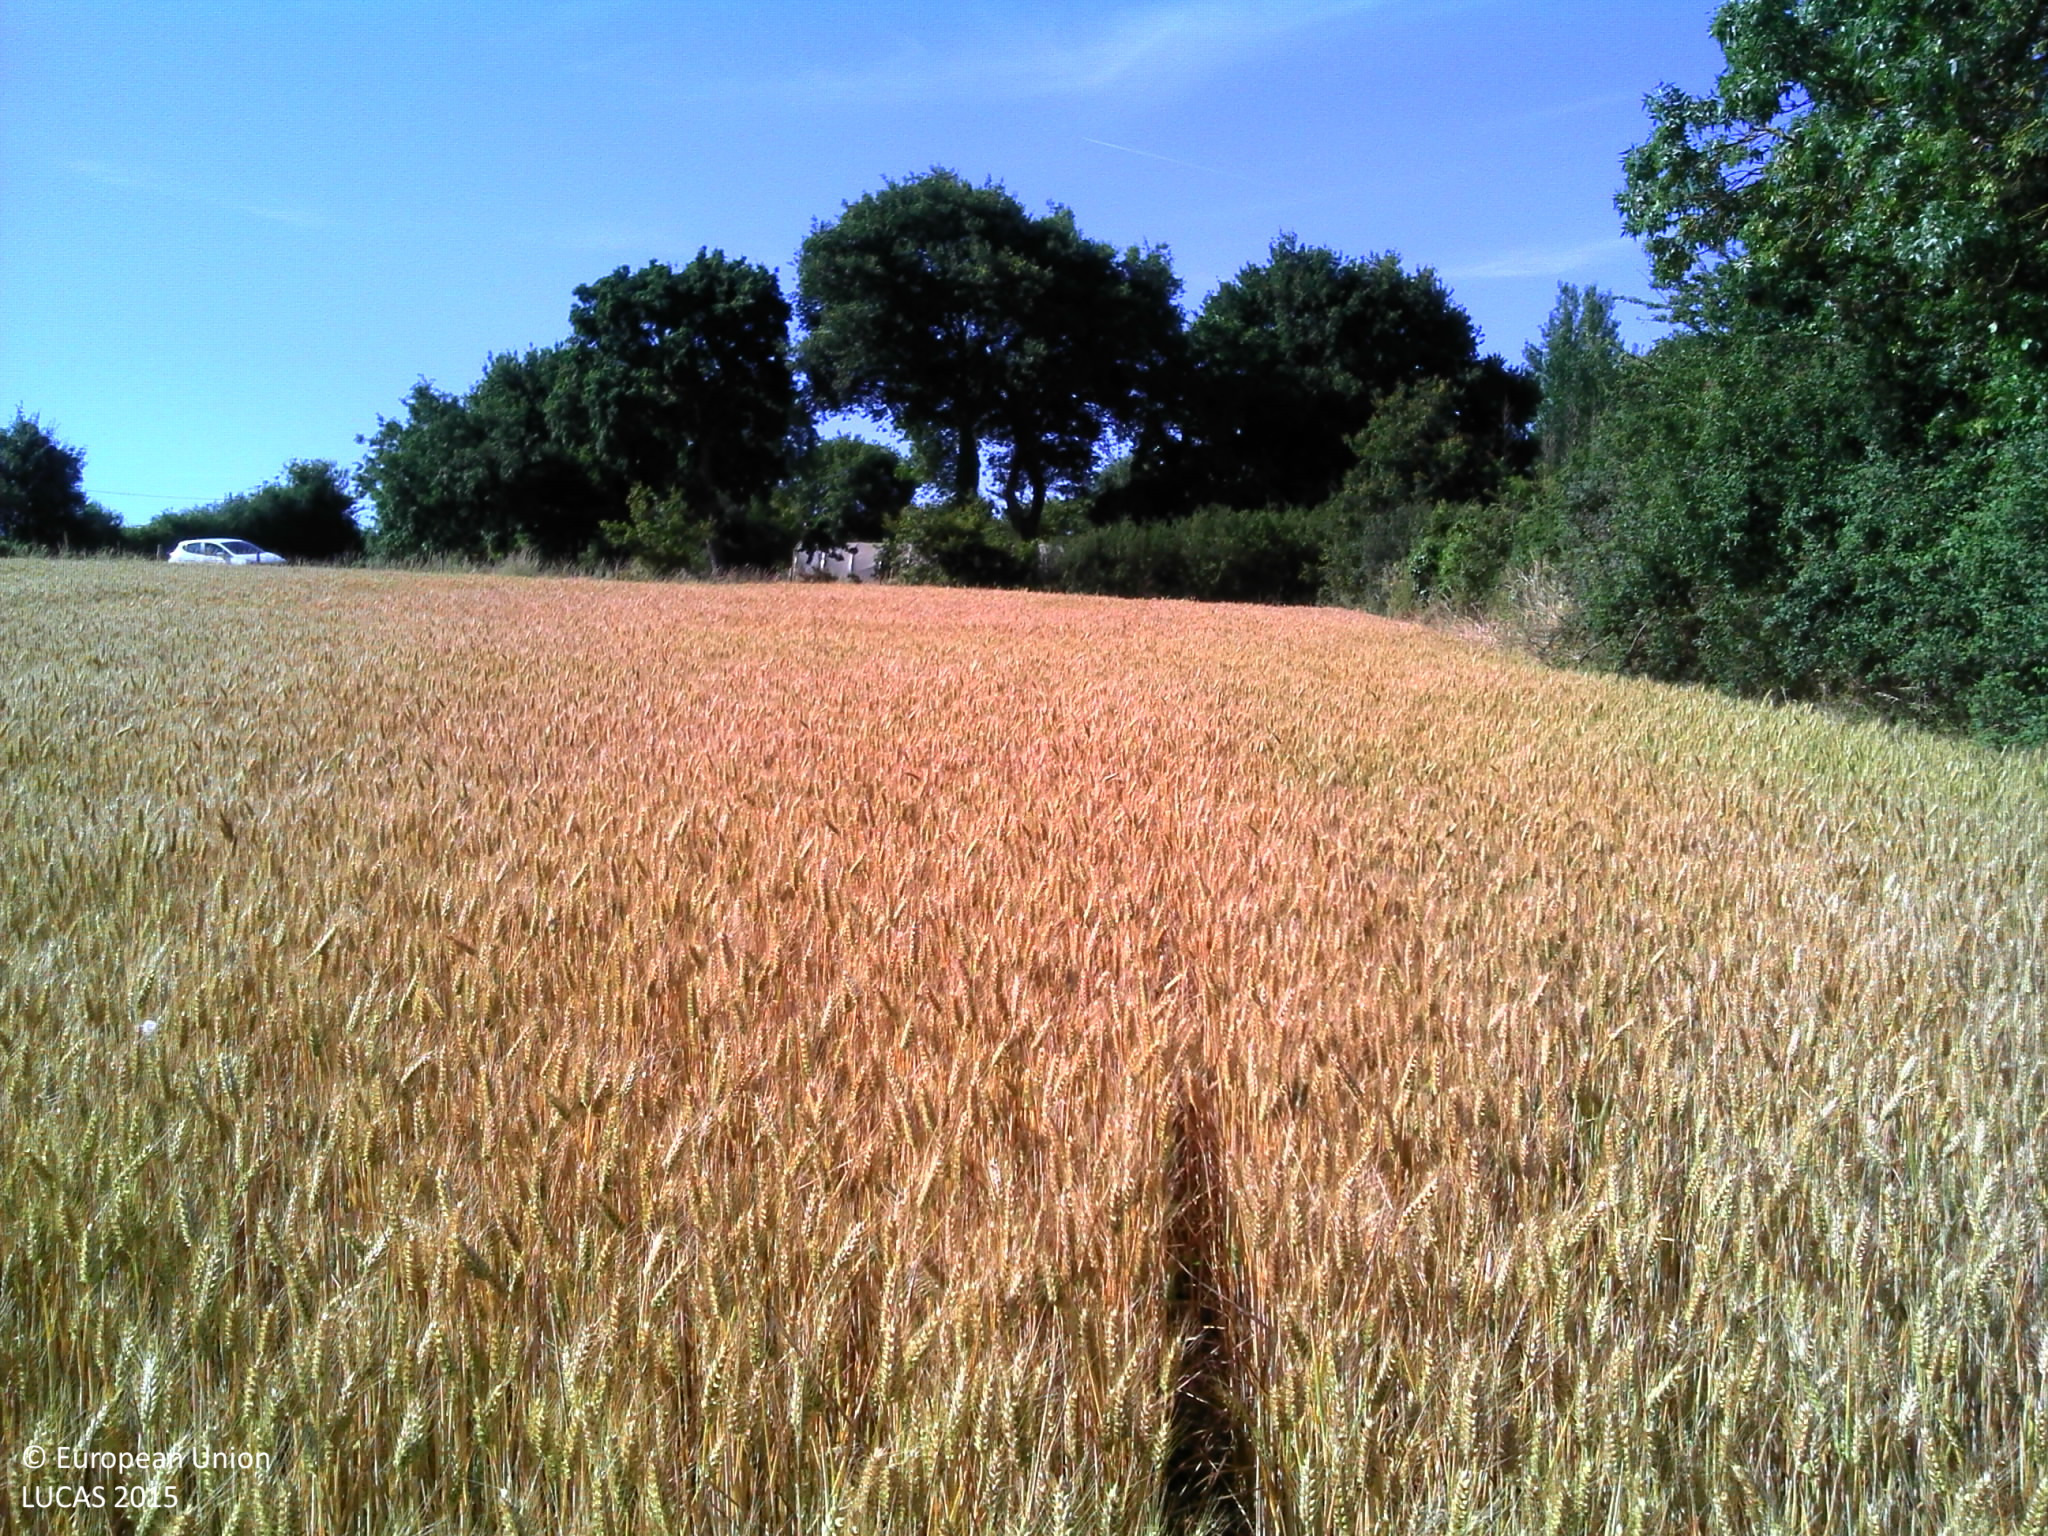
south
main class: Cropland
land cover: Common wheat
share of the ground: > 75 %
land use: Agriculture (excluding fallow land and kitchen gardens)
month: June
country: FR
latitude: 47.2494
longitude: -2.0594
